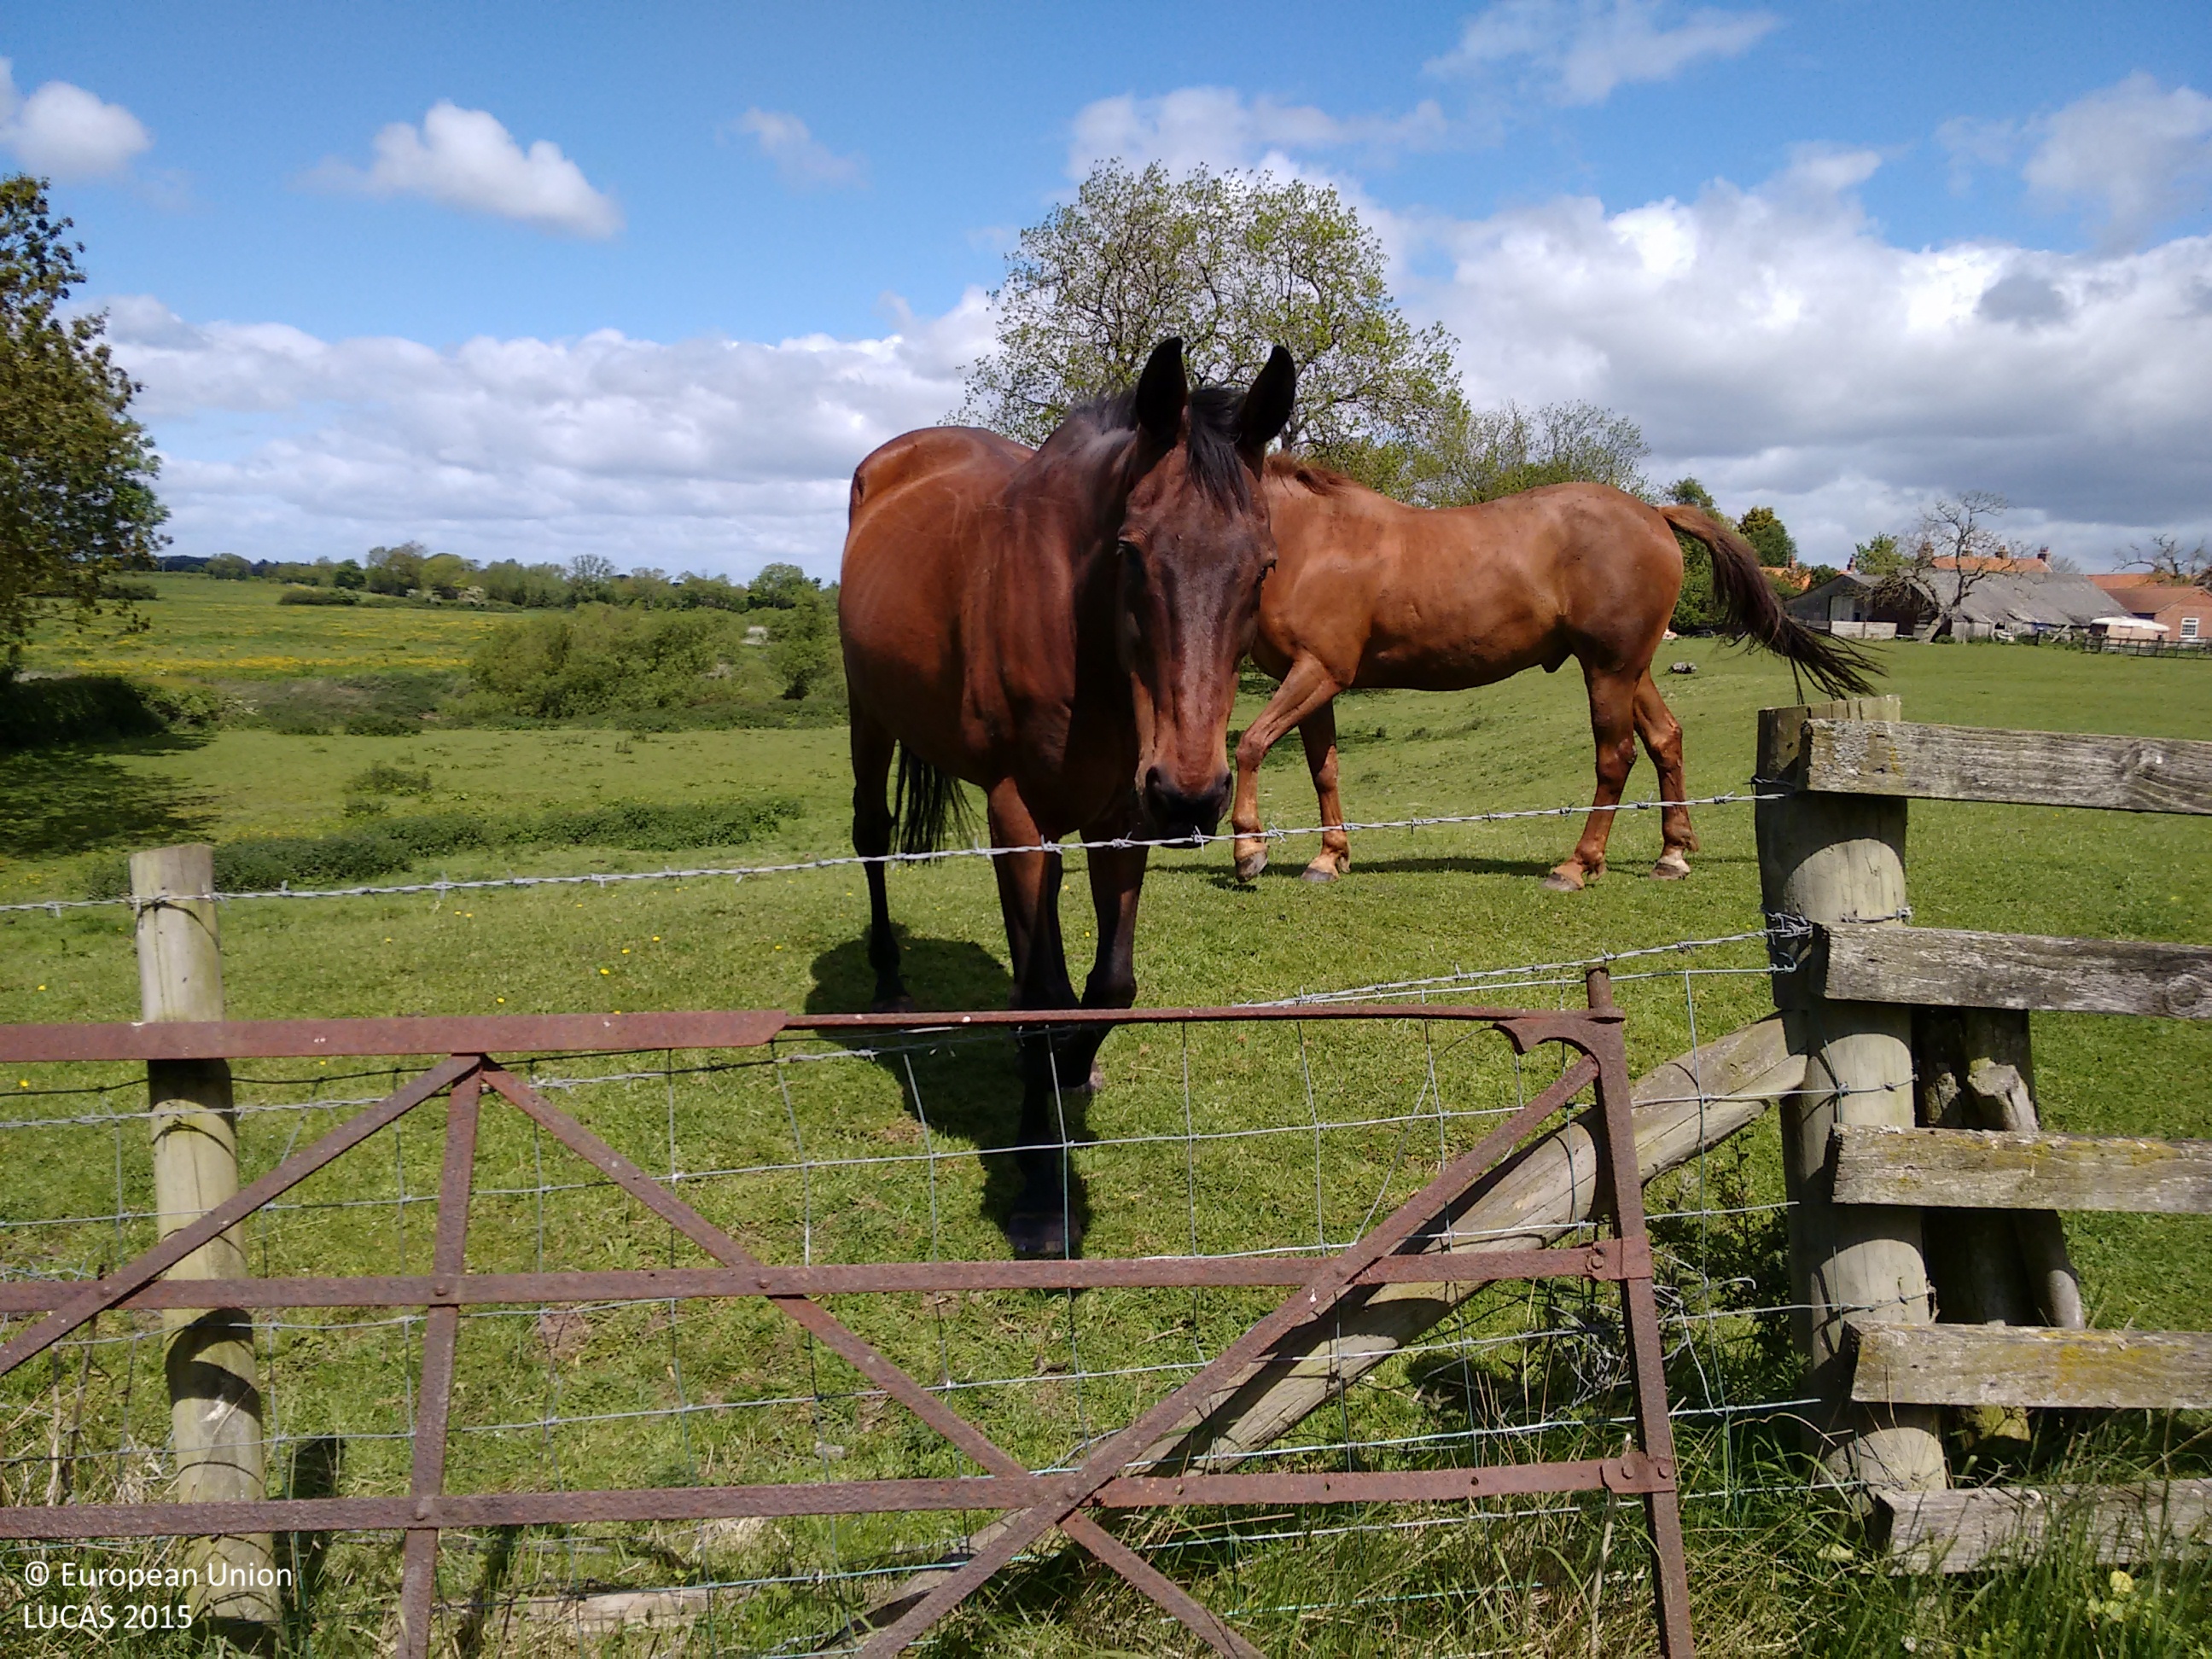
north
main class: Grassland
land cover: Grassland without tree/shrub cover
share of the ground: > 75 %
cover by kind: herbaceous plants 100 %
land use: Agriculture (excluding fallow land and kitchen gardens)
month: May
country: GB
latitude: 54.0037
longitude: -1.2290
